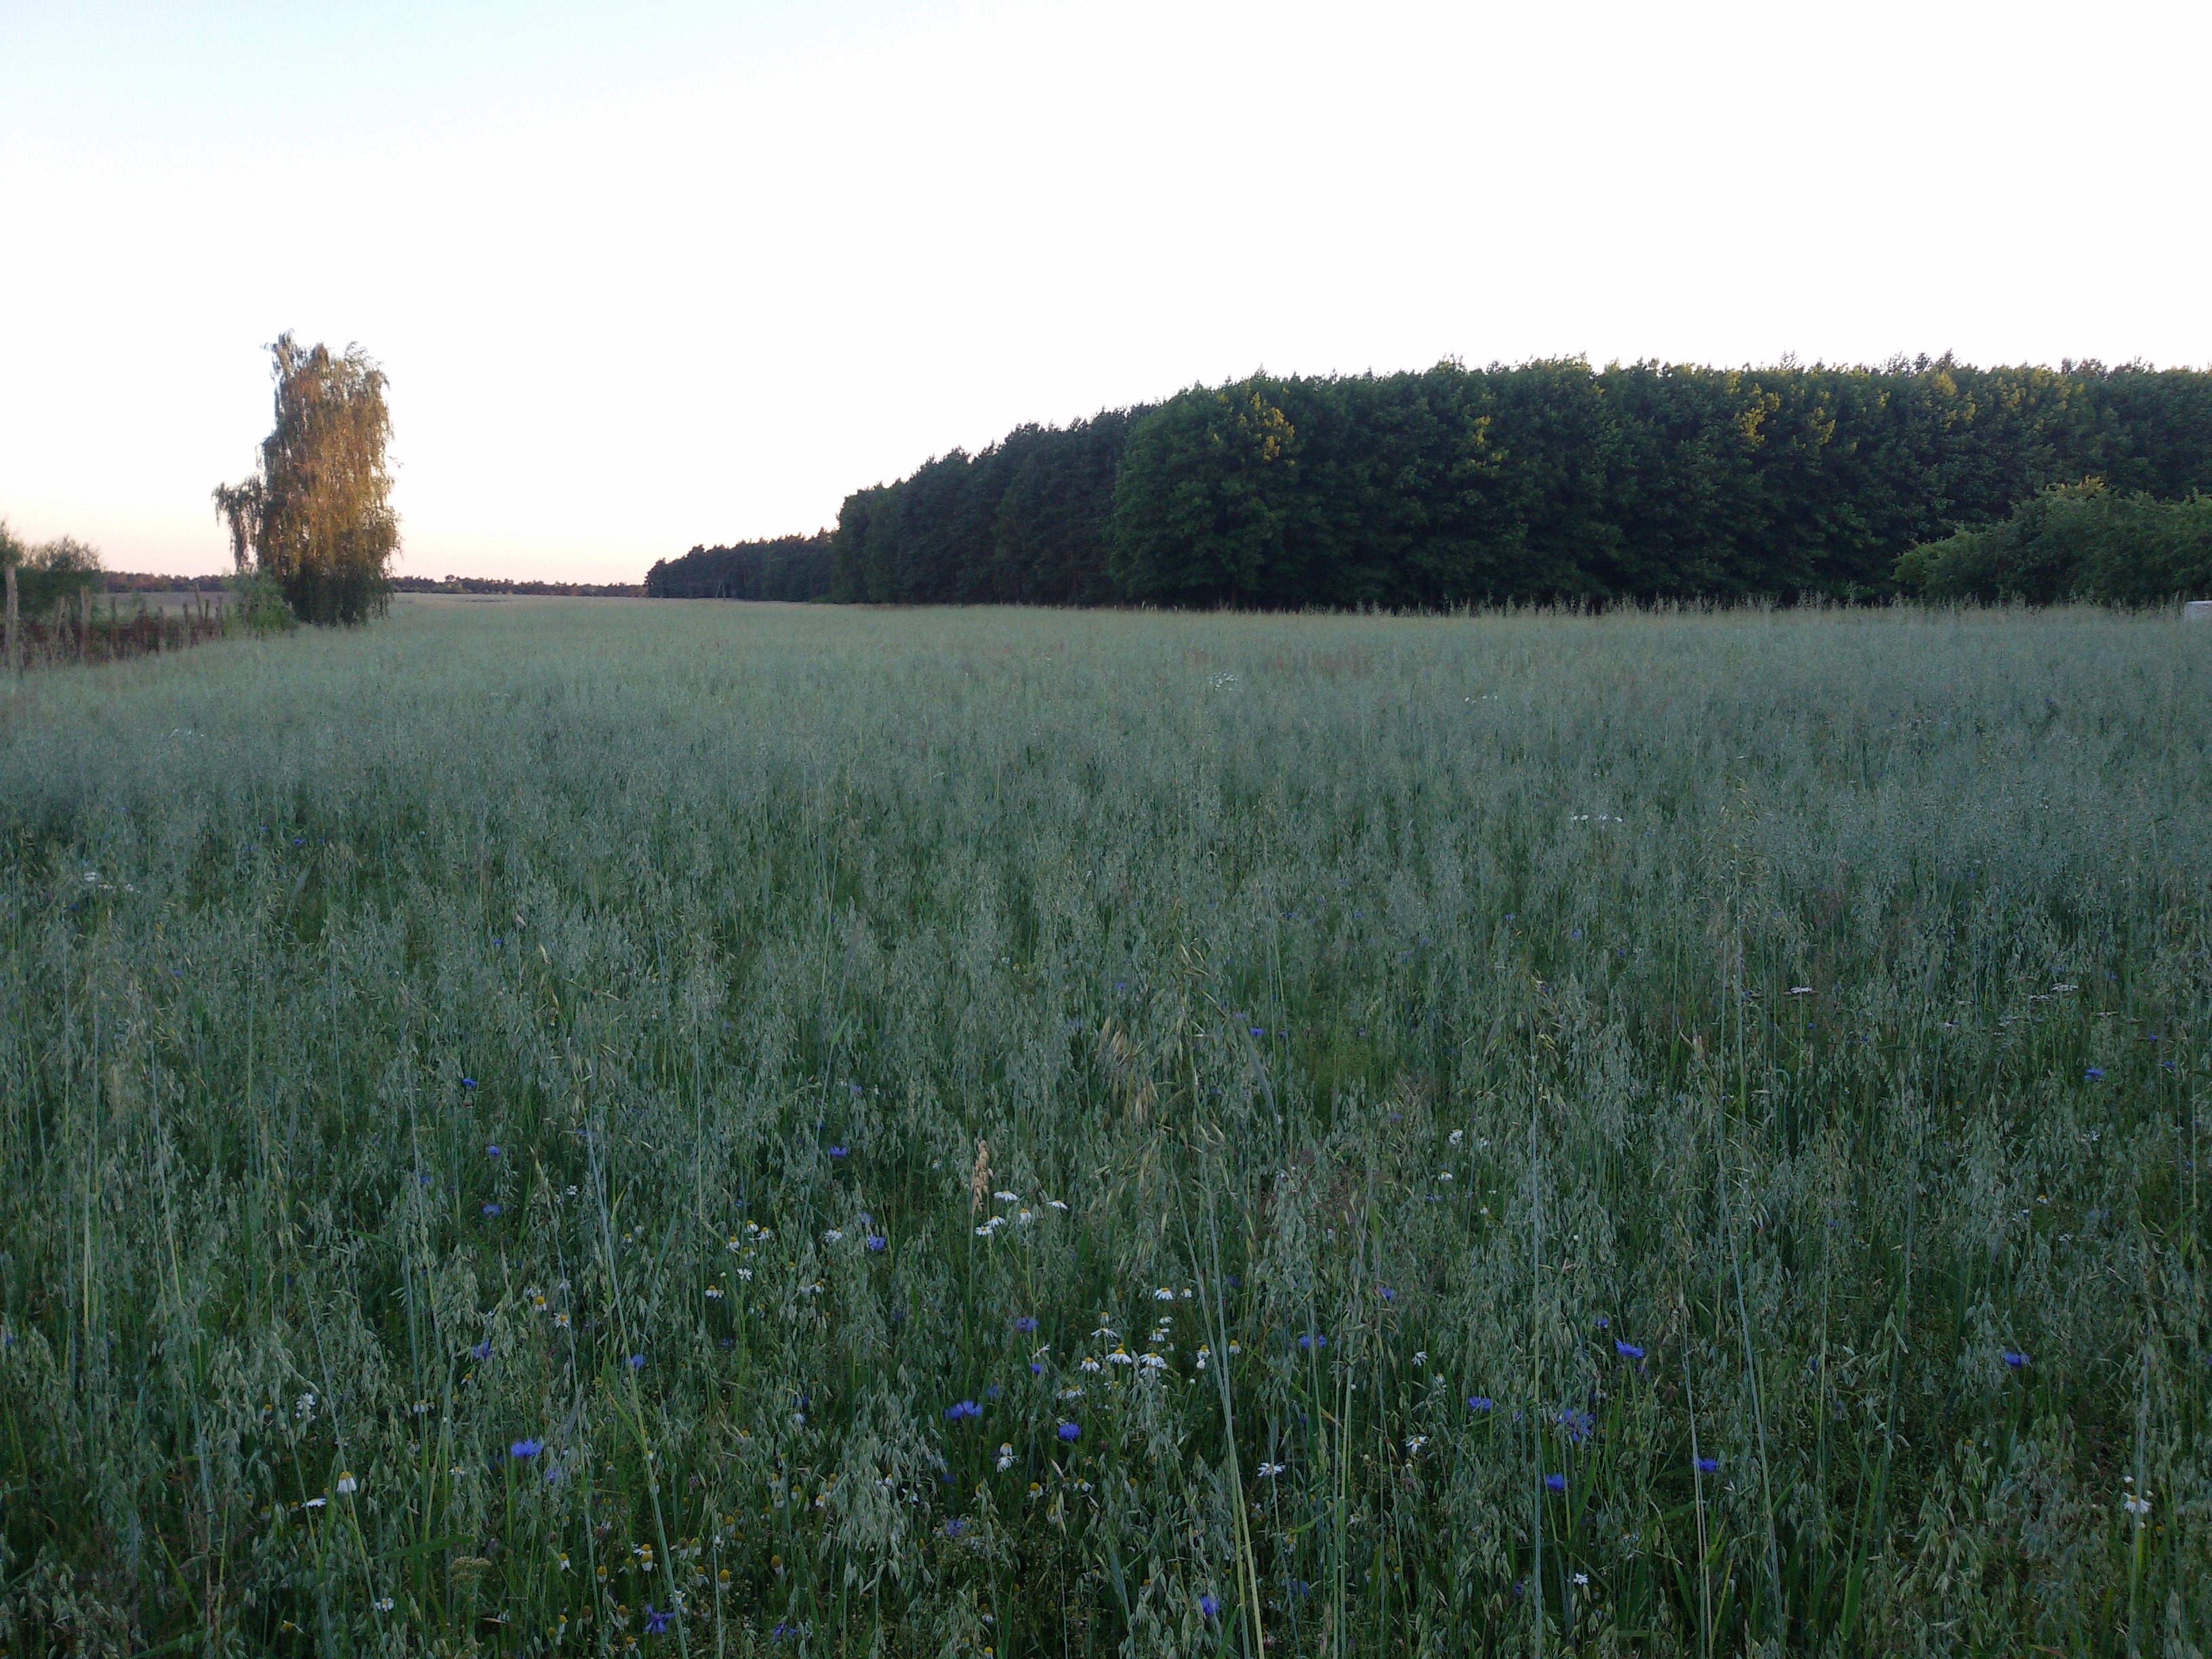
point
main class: Cropland
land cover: Oats
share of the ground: > 75 %
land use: Agriculture (excluding fallow land and kitchen gardens)
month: July
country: PL
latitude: 53.1551
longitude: 14.5325
